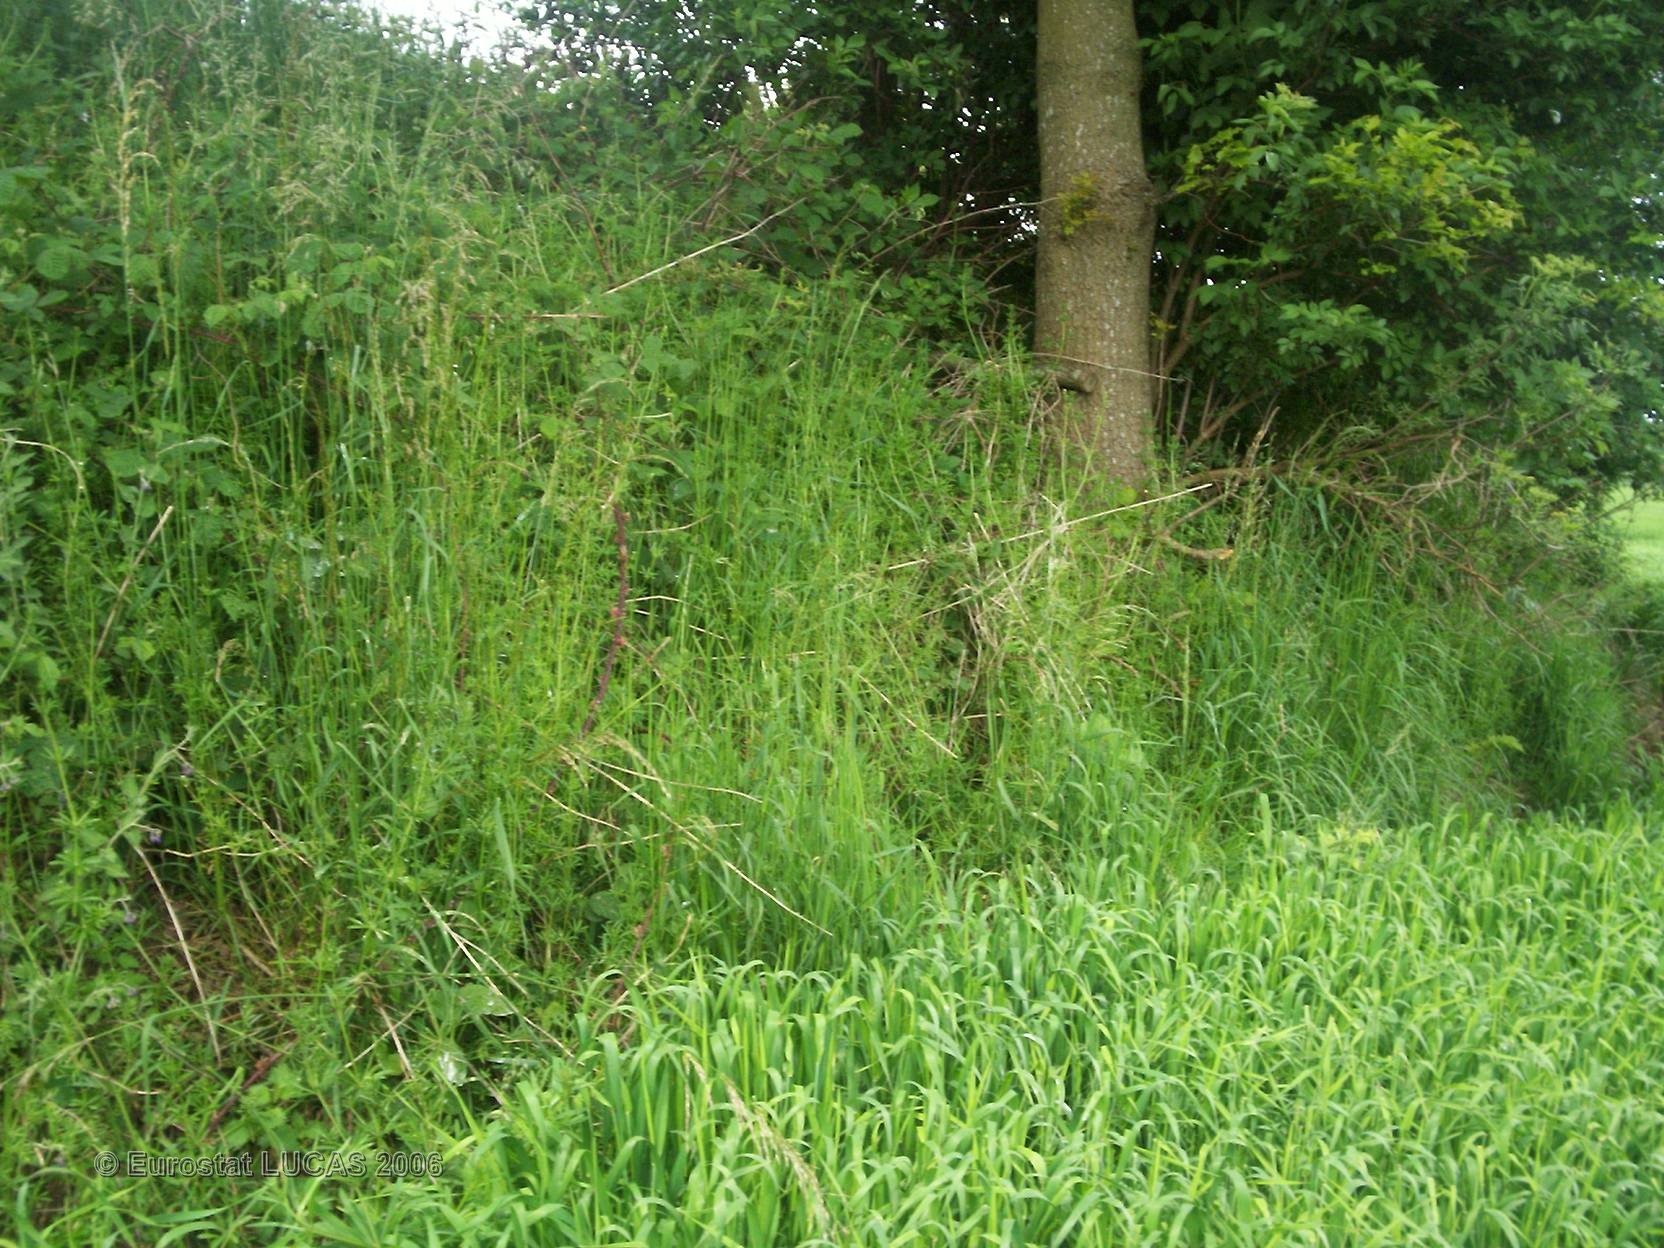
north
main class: Cropland
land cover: Barley
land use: Agriculture (excluding fallow land and kitchen gardens)
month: May
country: FR
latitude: 49.6872
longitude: 0.3941
